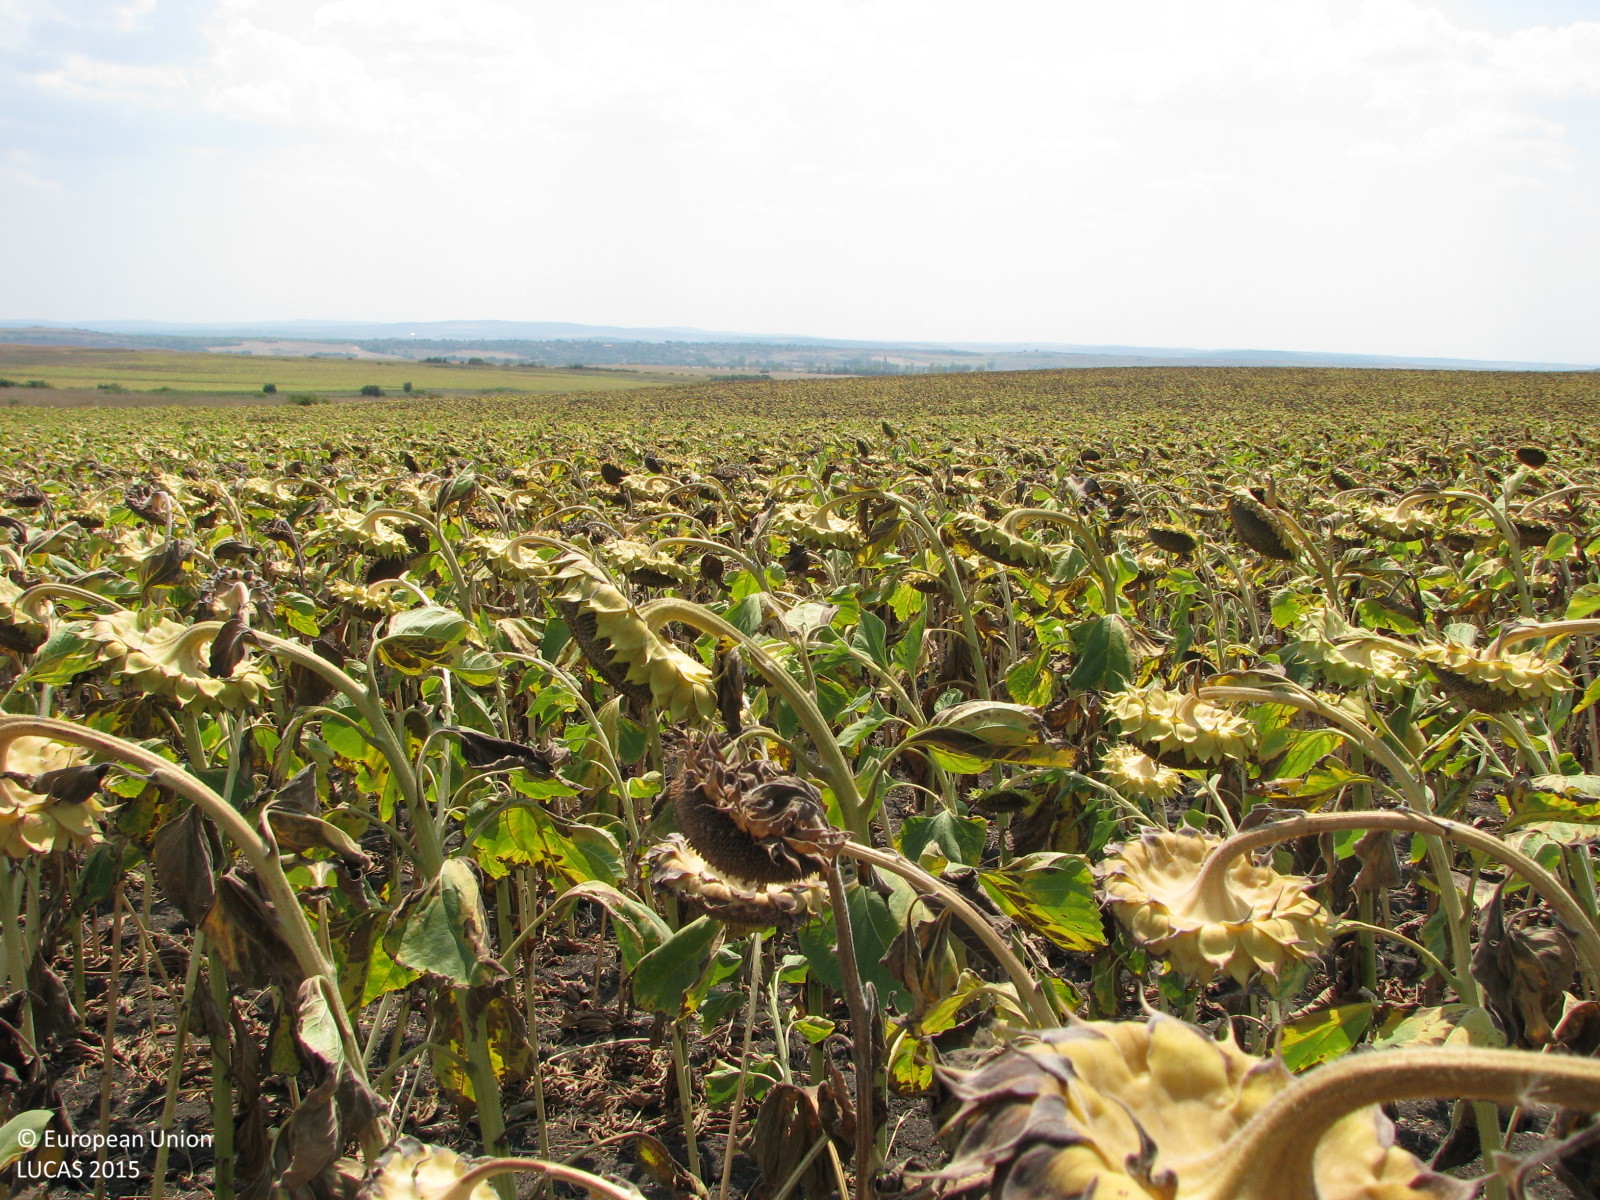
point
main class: Cropland
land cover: Sunflower
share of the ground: > 75 %
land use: Agriculture (excluding fallow land and kitchen gardens)
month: August
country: BG
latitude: 42.1857
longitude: 26.6433
